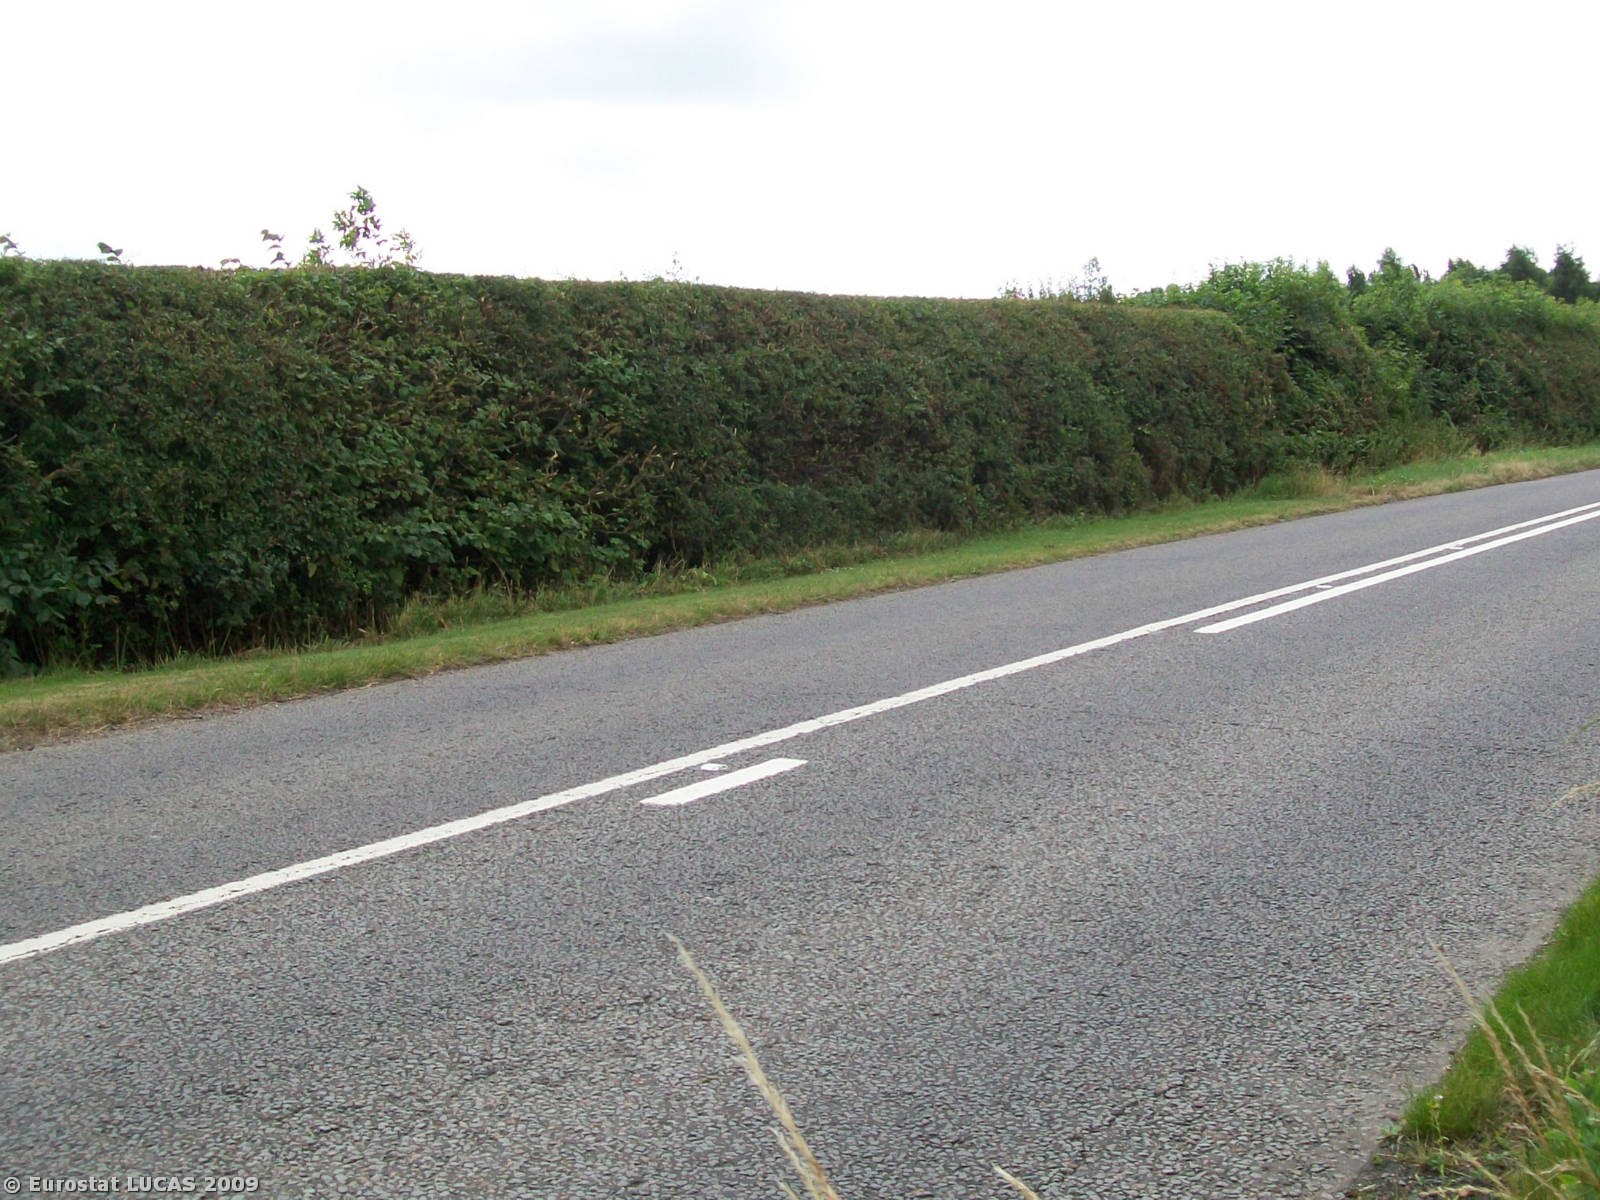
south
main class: Grassland
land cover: Grassland without tree/shrub cover
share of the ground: > 75 %
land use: Agriculture (excluding fallow land and kitchen gardens)
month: July
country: GB
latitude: 51.9659
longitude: -0.8863
